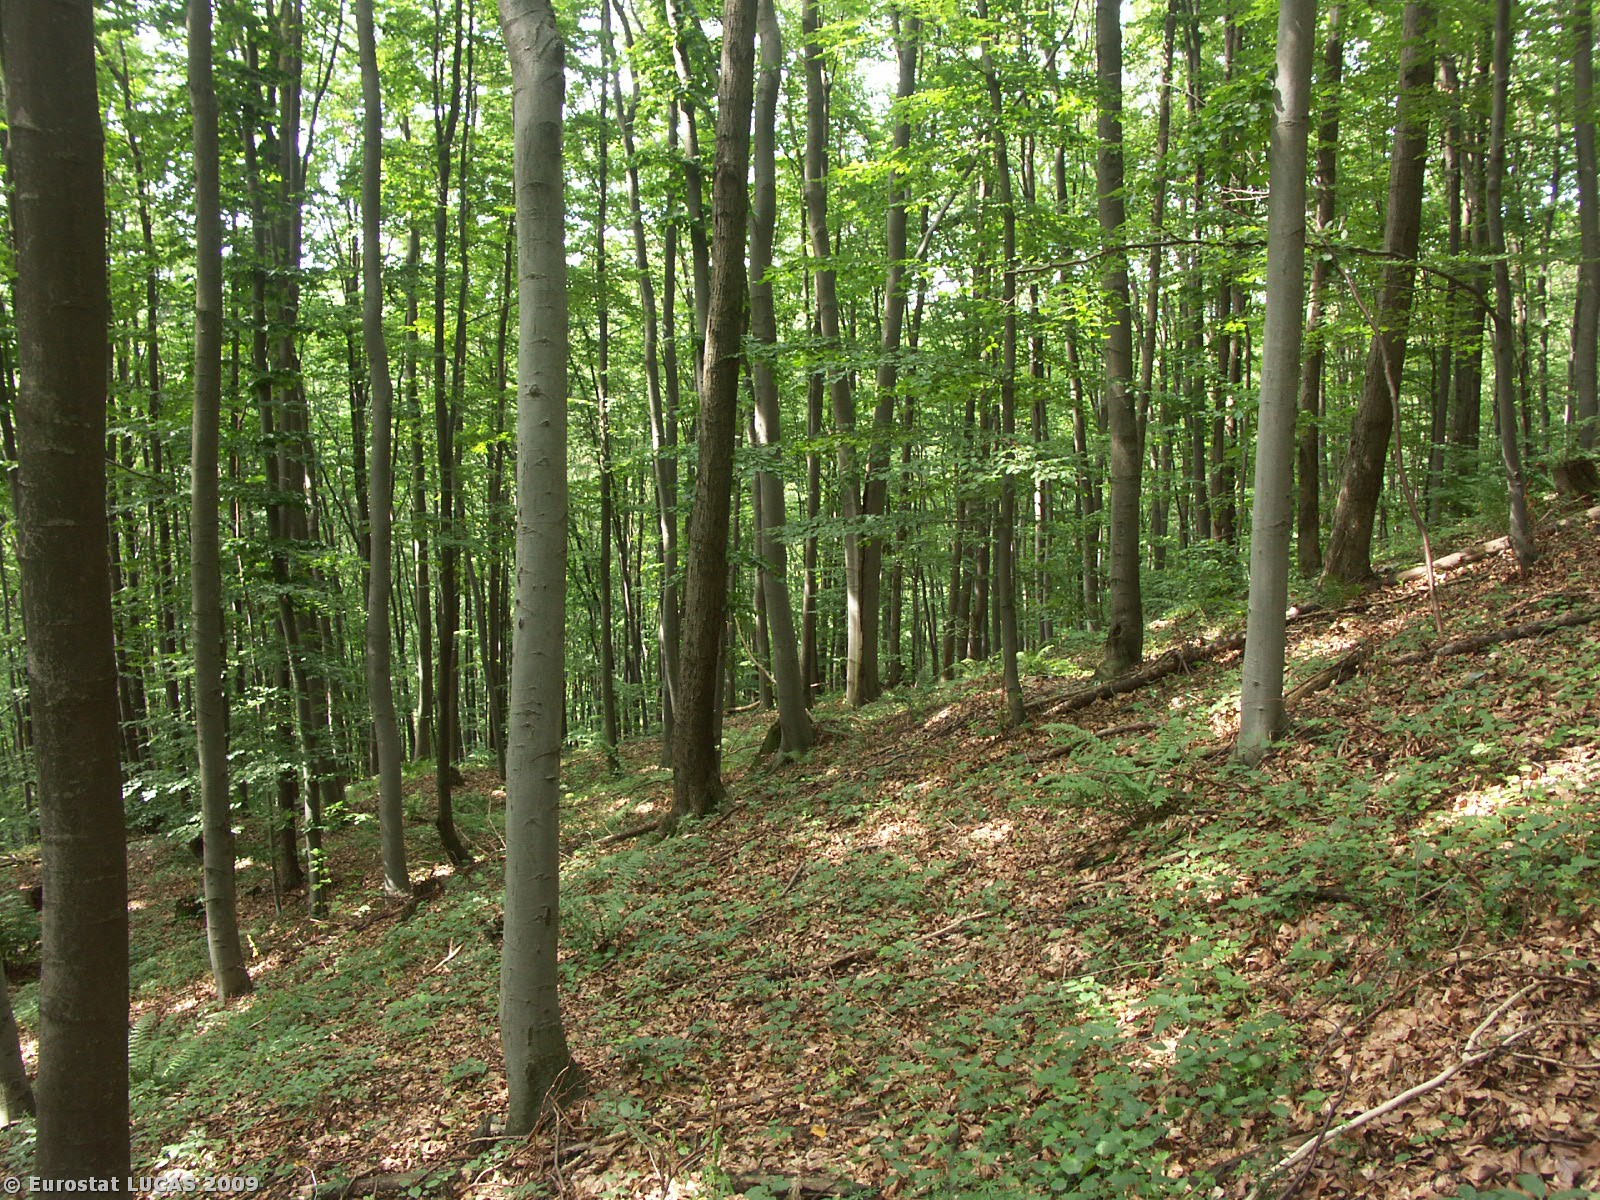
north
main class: Woodland
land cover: Broadleaved woodland
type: beech forest
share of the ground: > 75 %
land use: Forestry
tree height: > 5 m
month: July
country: CZ
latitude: 49.8464
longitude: 17.2284
